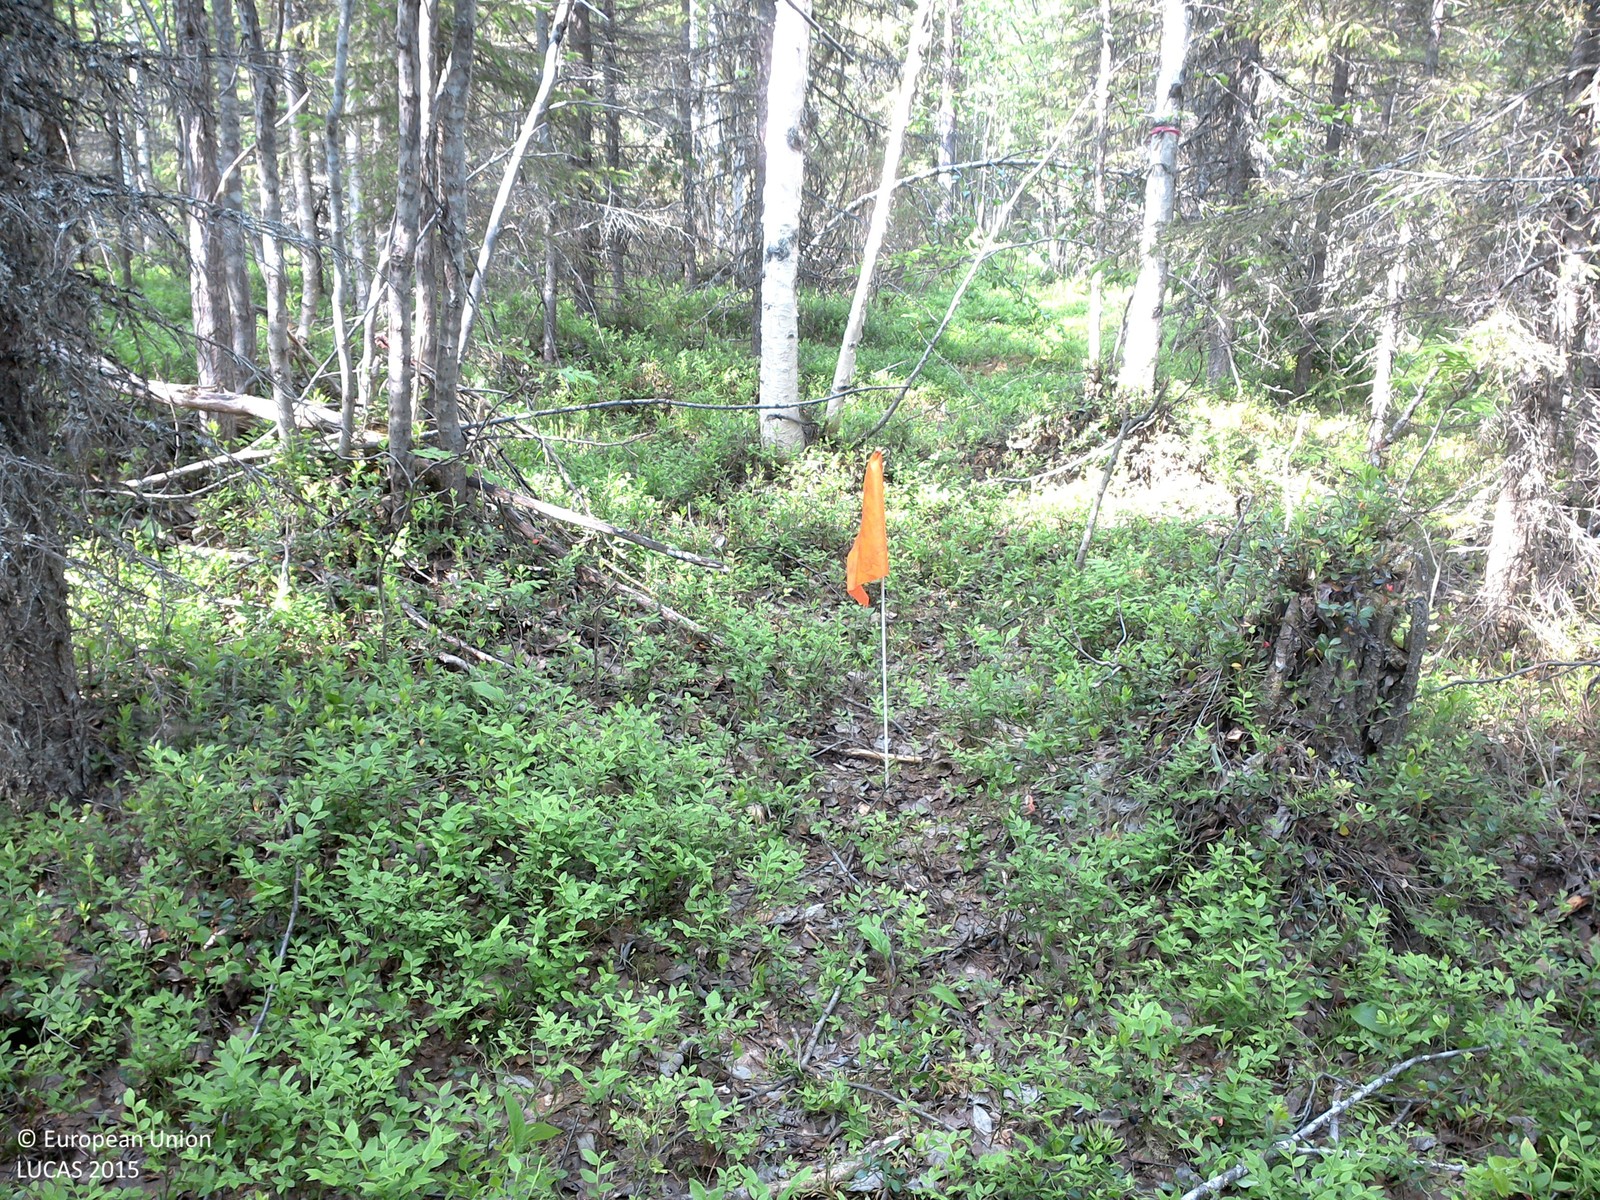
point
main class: Woodland
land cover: Spruce dominated mixed woodland
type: boreal forest
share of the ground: 10 - 25 %
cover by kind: shrubs 55 %, coniferous forest trees 30 %, broadleaved forest trees 15 %
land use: Forestry
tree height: > 5 m
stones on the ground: < 10 %
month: July
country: SE
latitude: 66.8483
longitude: 23.5874
